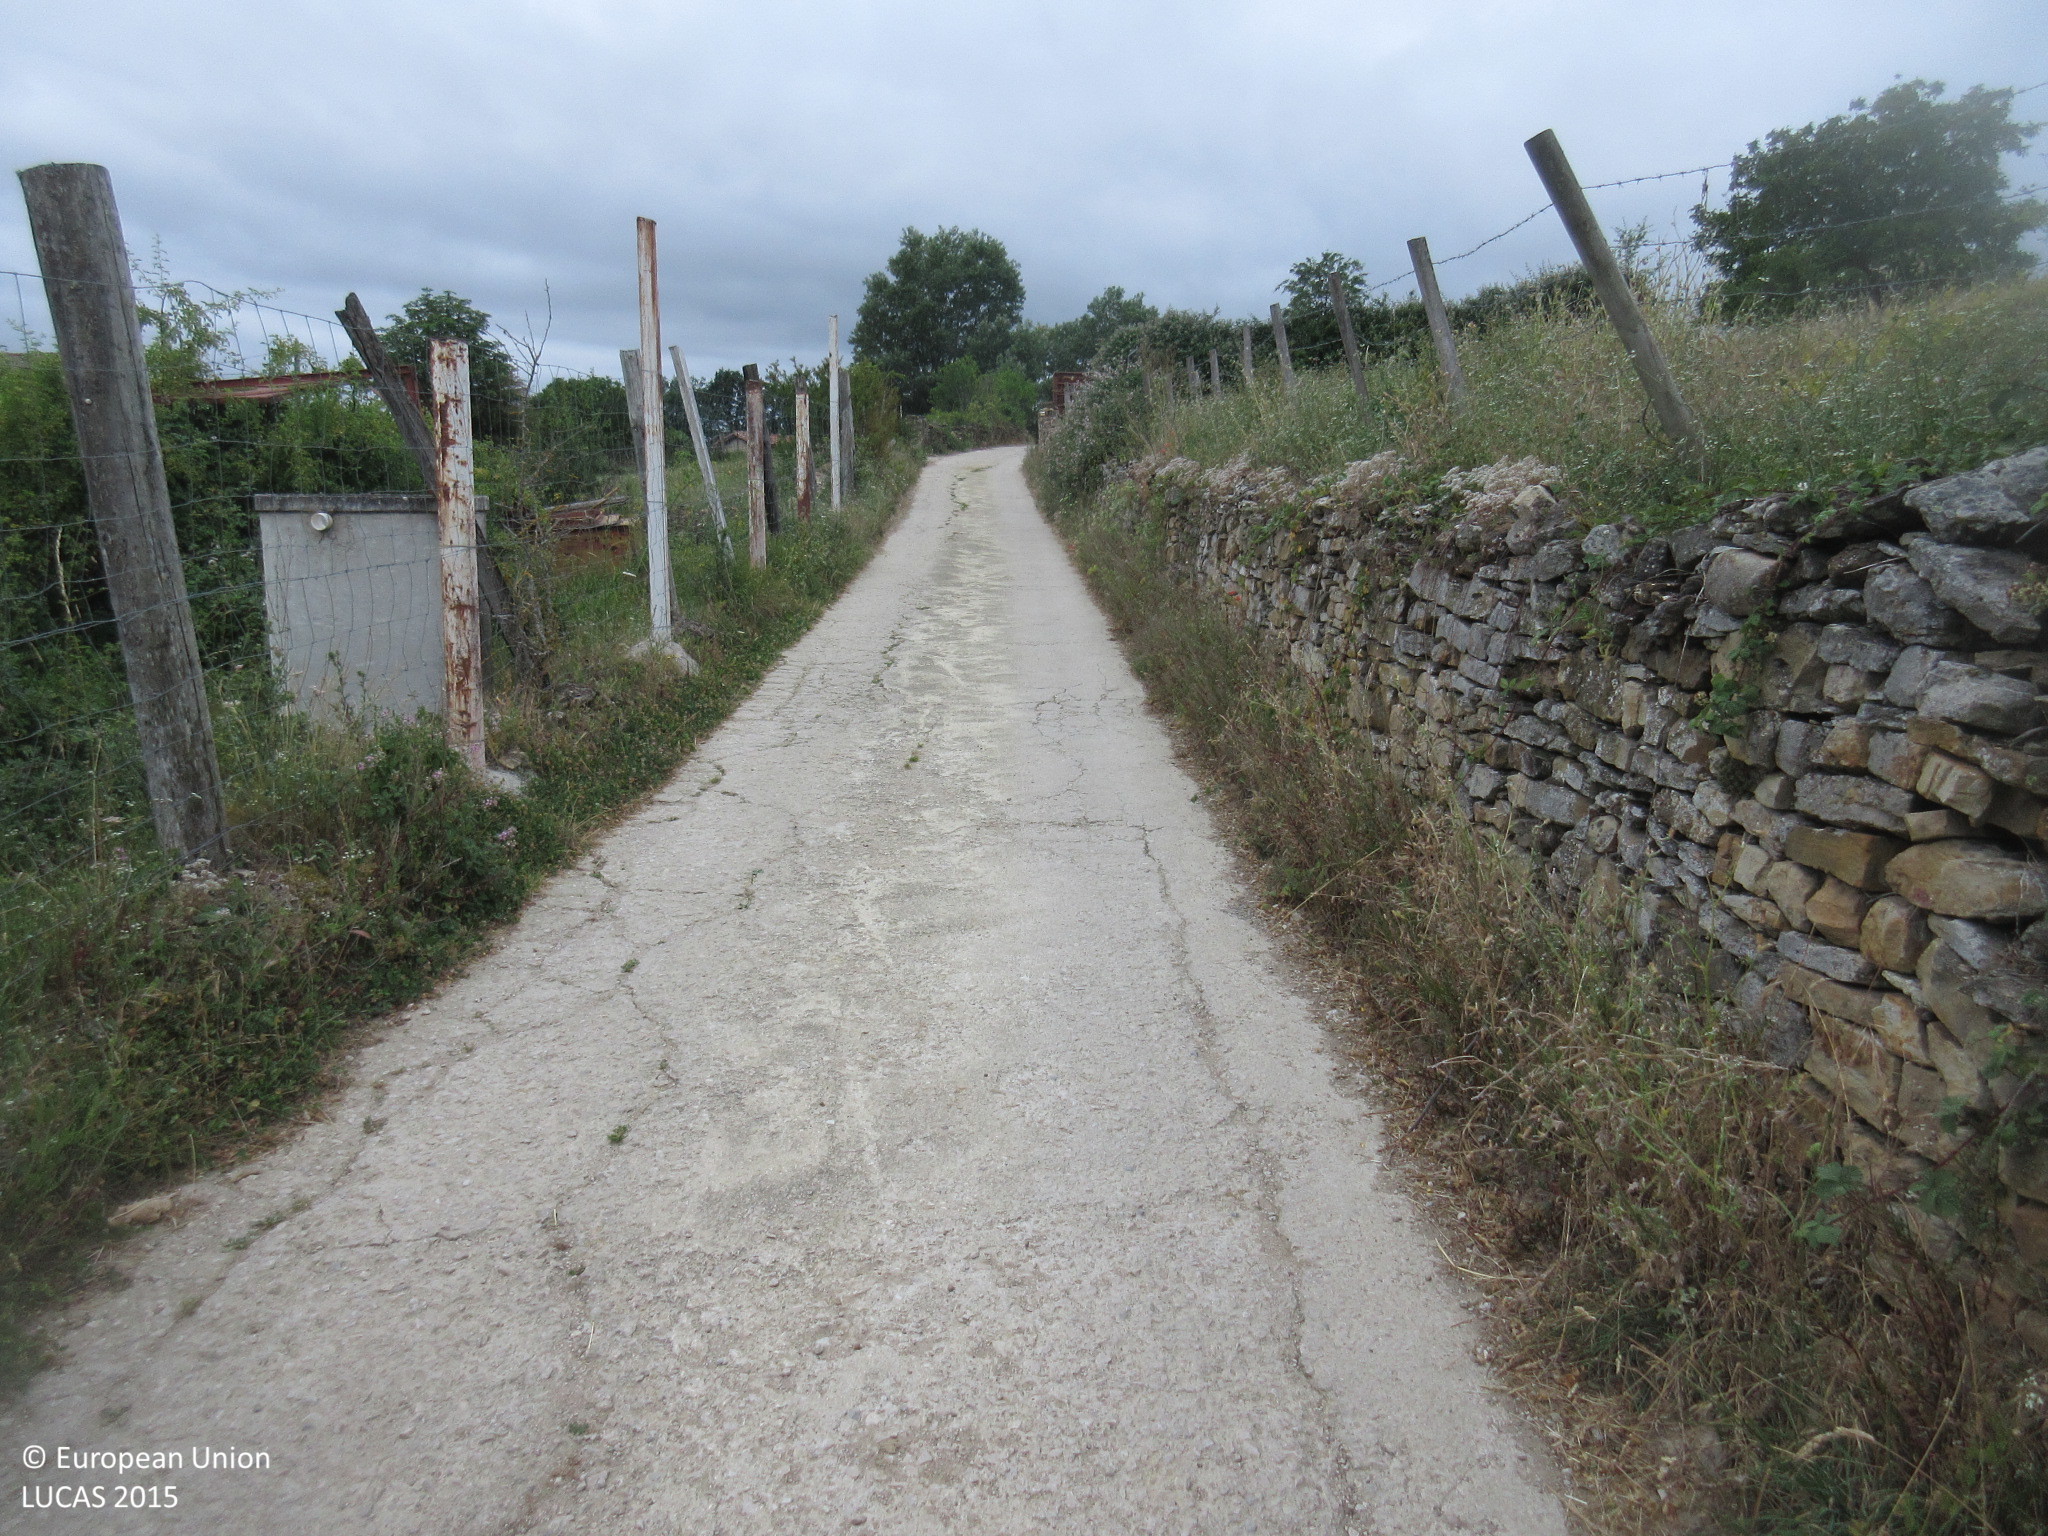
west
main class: Shrubland
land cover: Shrubland with sparse tree cover
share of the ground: > 75 %
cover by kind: shrubs 95 %, broadleaved forest trees 5 %
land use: Semi-natural and natural areas not in use
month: July
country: ES
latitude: 43.0749
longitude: -3.5387
